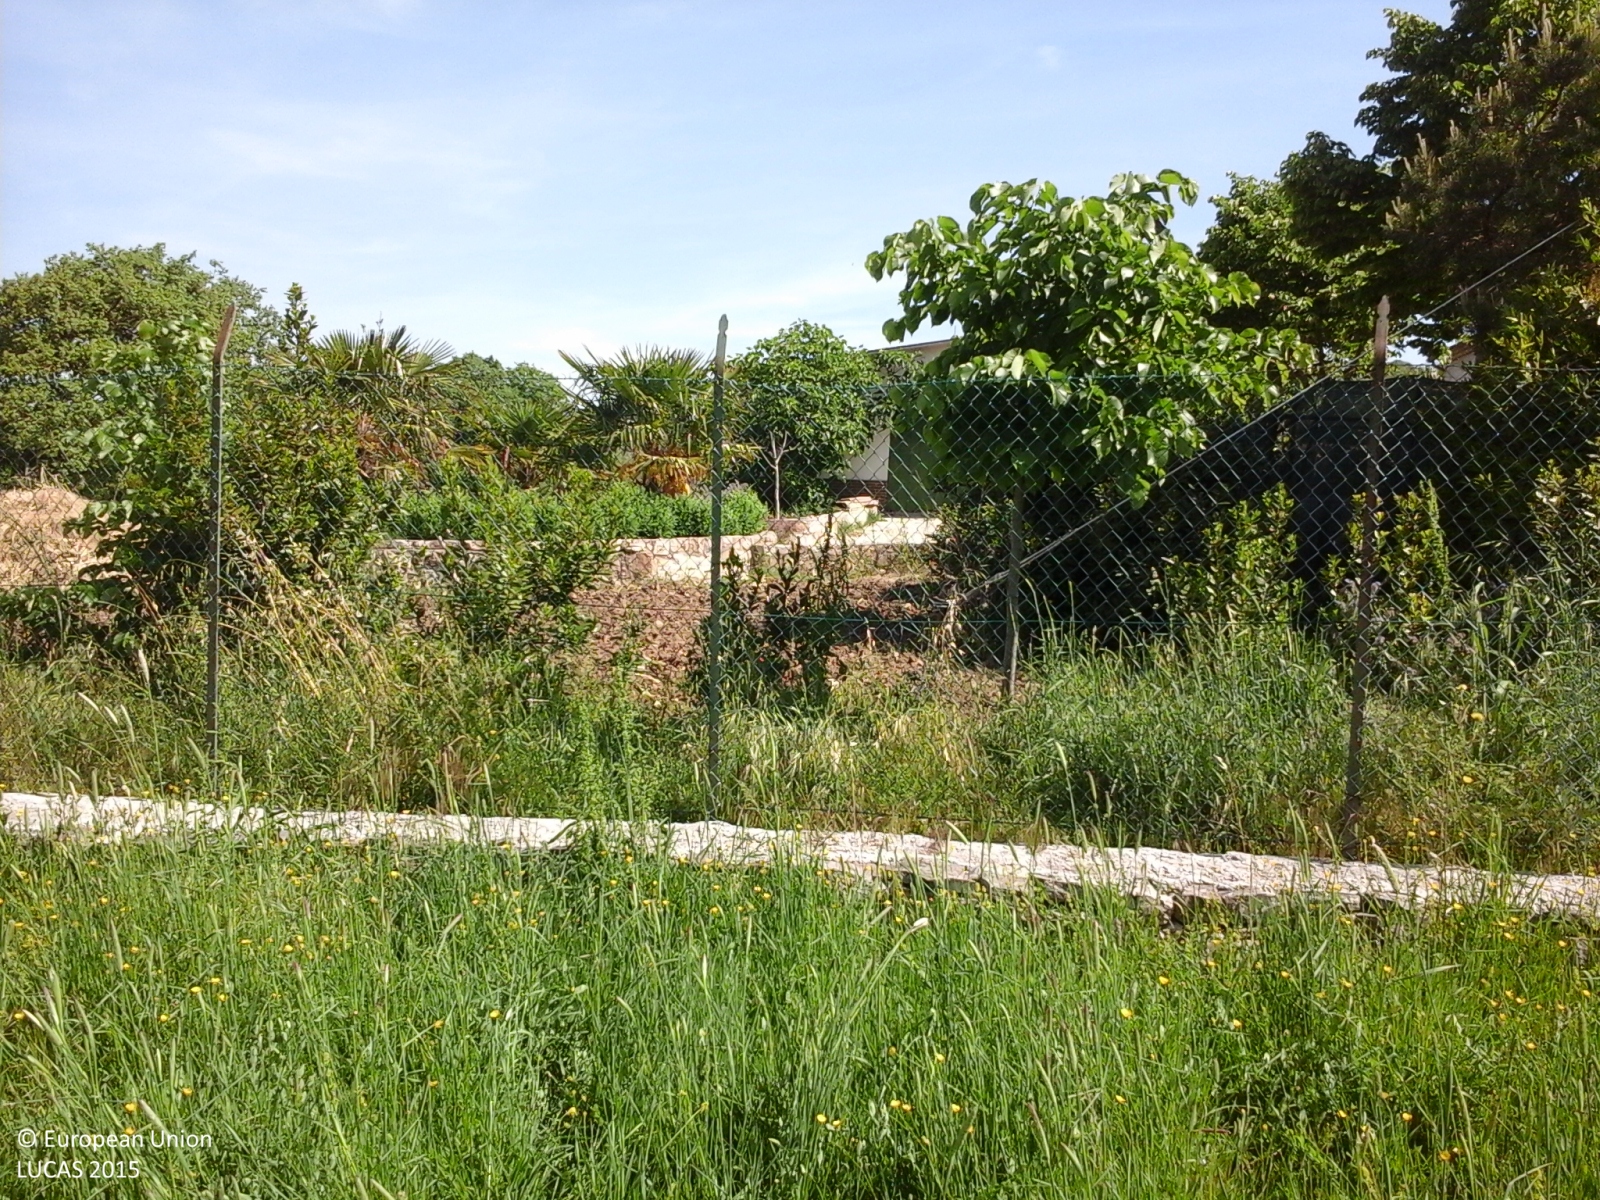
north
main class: Grassland
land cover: Grassland without tree/shrub cover
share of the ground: > 75 %
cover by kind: herbaceous plants 100 %
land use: Abandoned areas
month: May
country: IT
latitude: 41.3277
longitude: 14.7976
